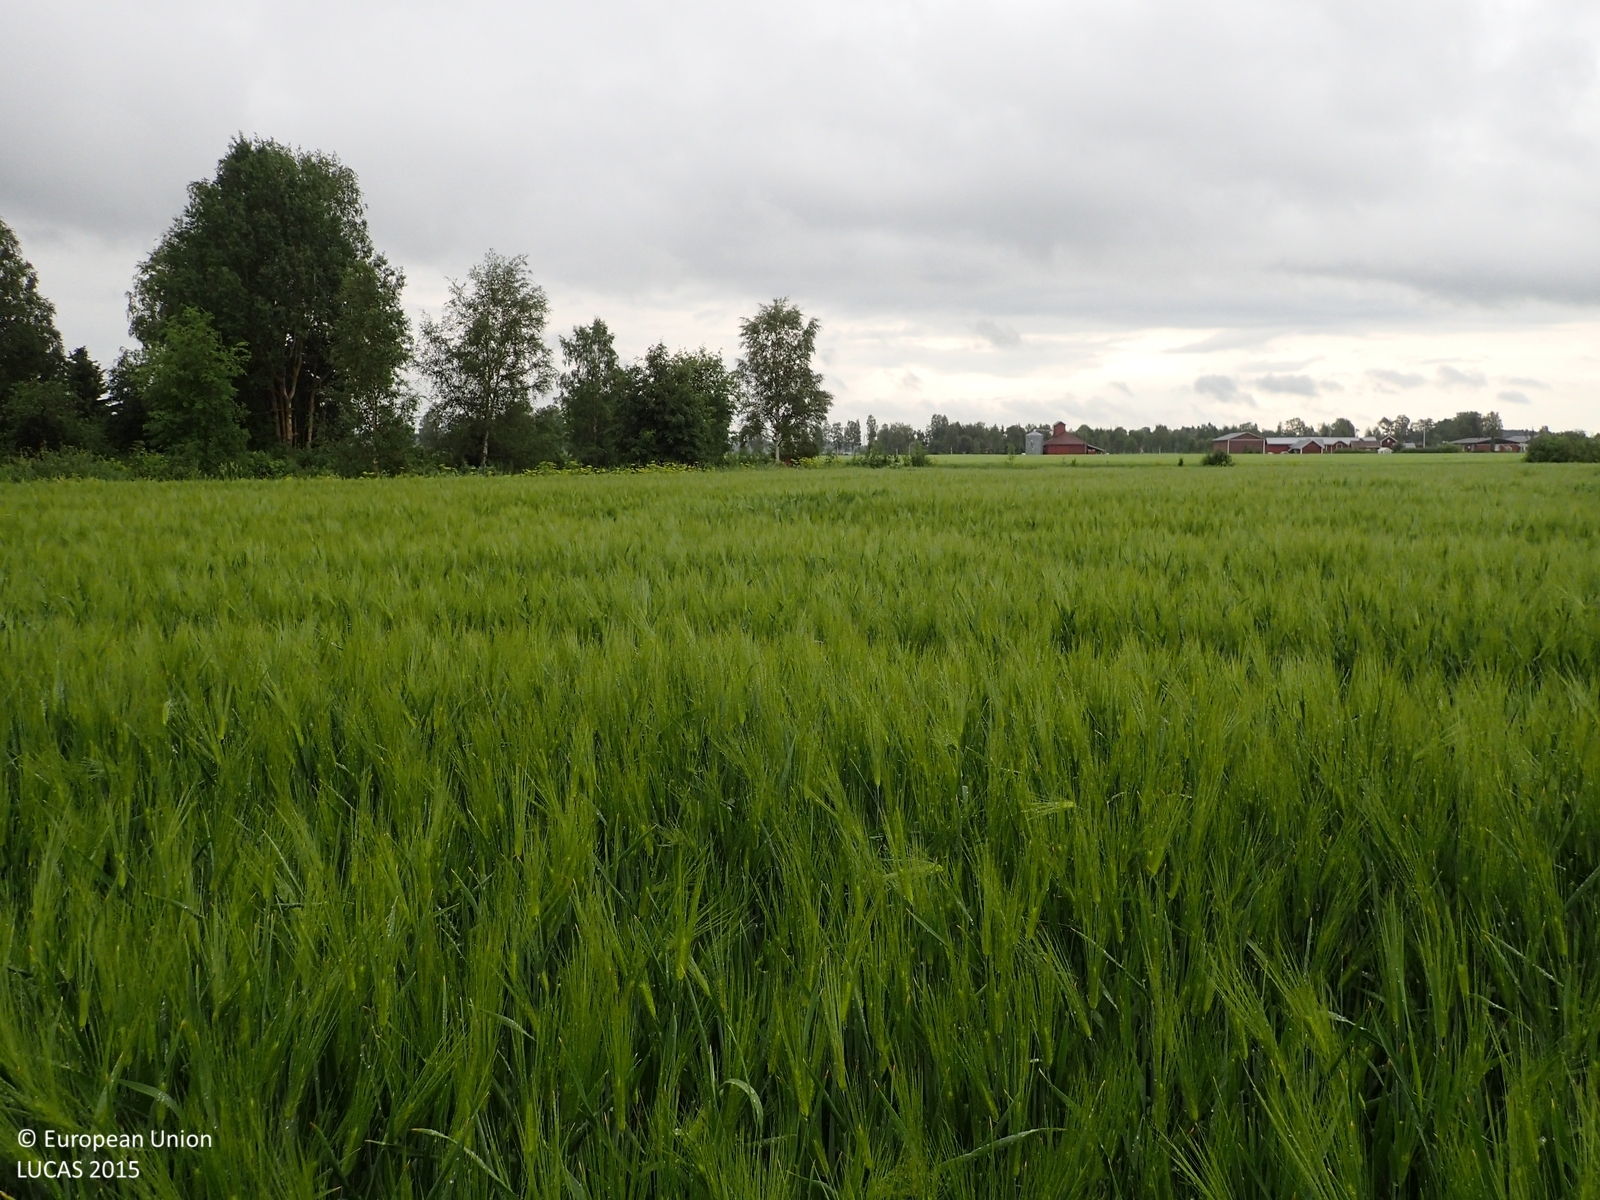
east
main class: Cropland
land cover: Barley
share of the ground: > 75 %
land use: Agriculture (excluding fallow land and kitchen gardens)
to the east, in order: Barley
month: July
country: FI
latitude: 62.9970
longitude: 21.9088
